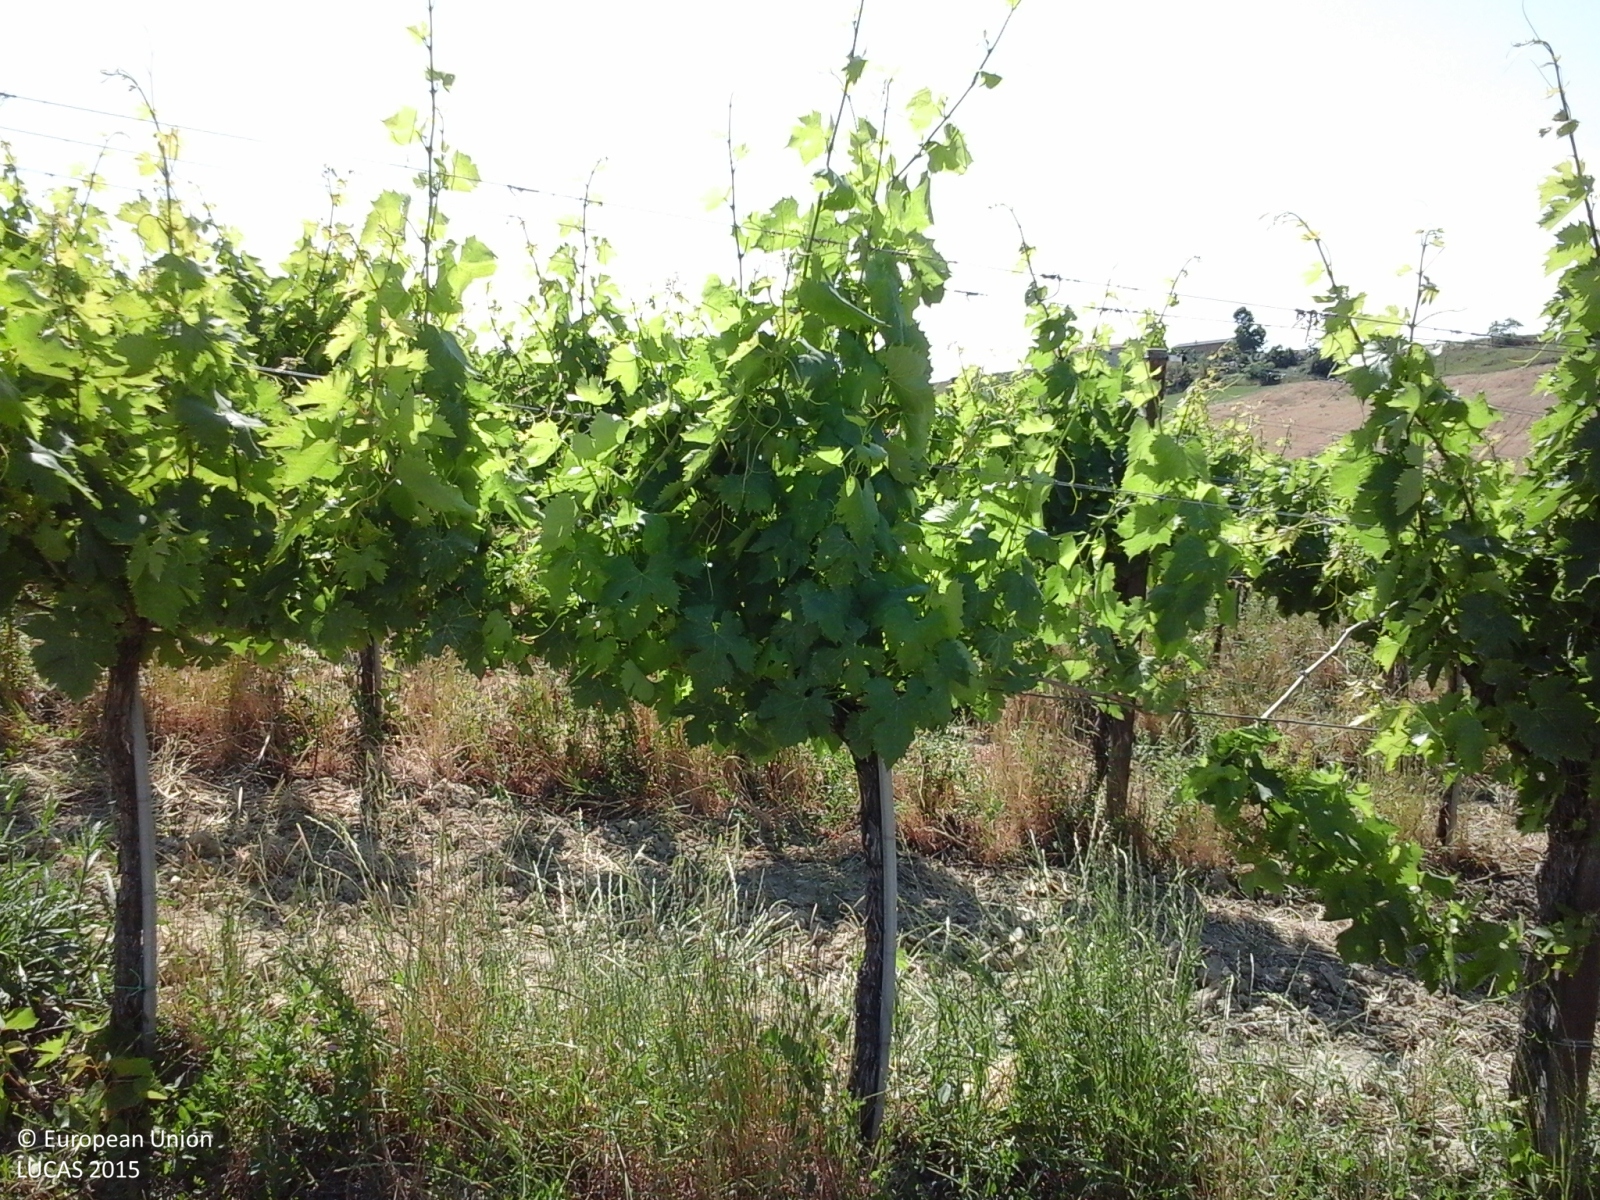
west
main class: Cropland
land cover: Vineyards
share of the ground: > 75 %
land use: Agriculture (excluding fallow land and kitchen gardens)
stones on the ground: < 10 %
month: May
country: IT
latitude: 42.1380
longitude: 14.4990
